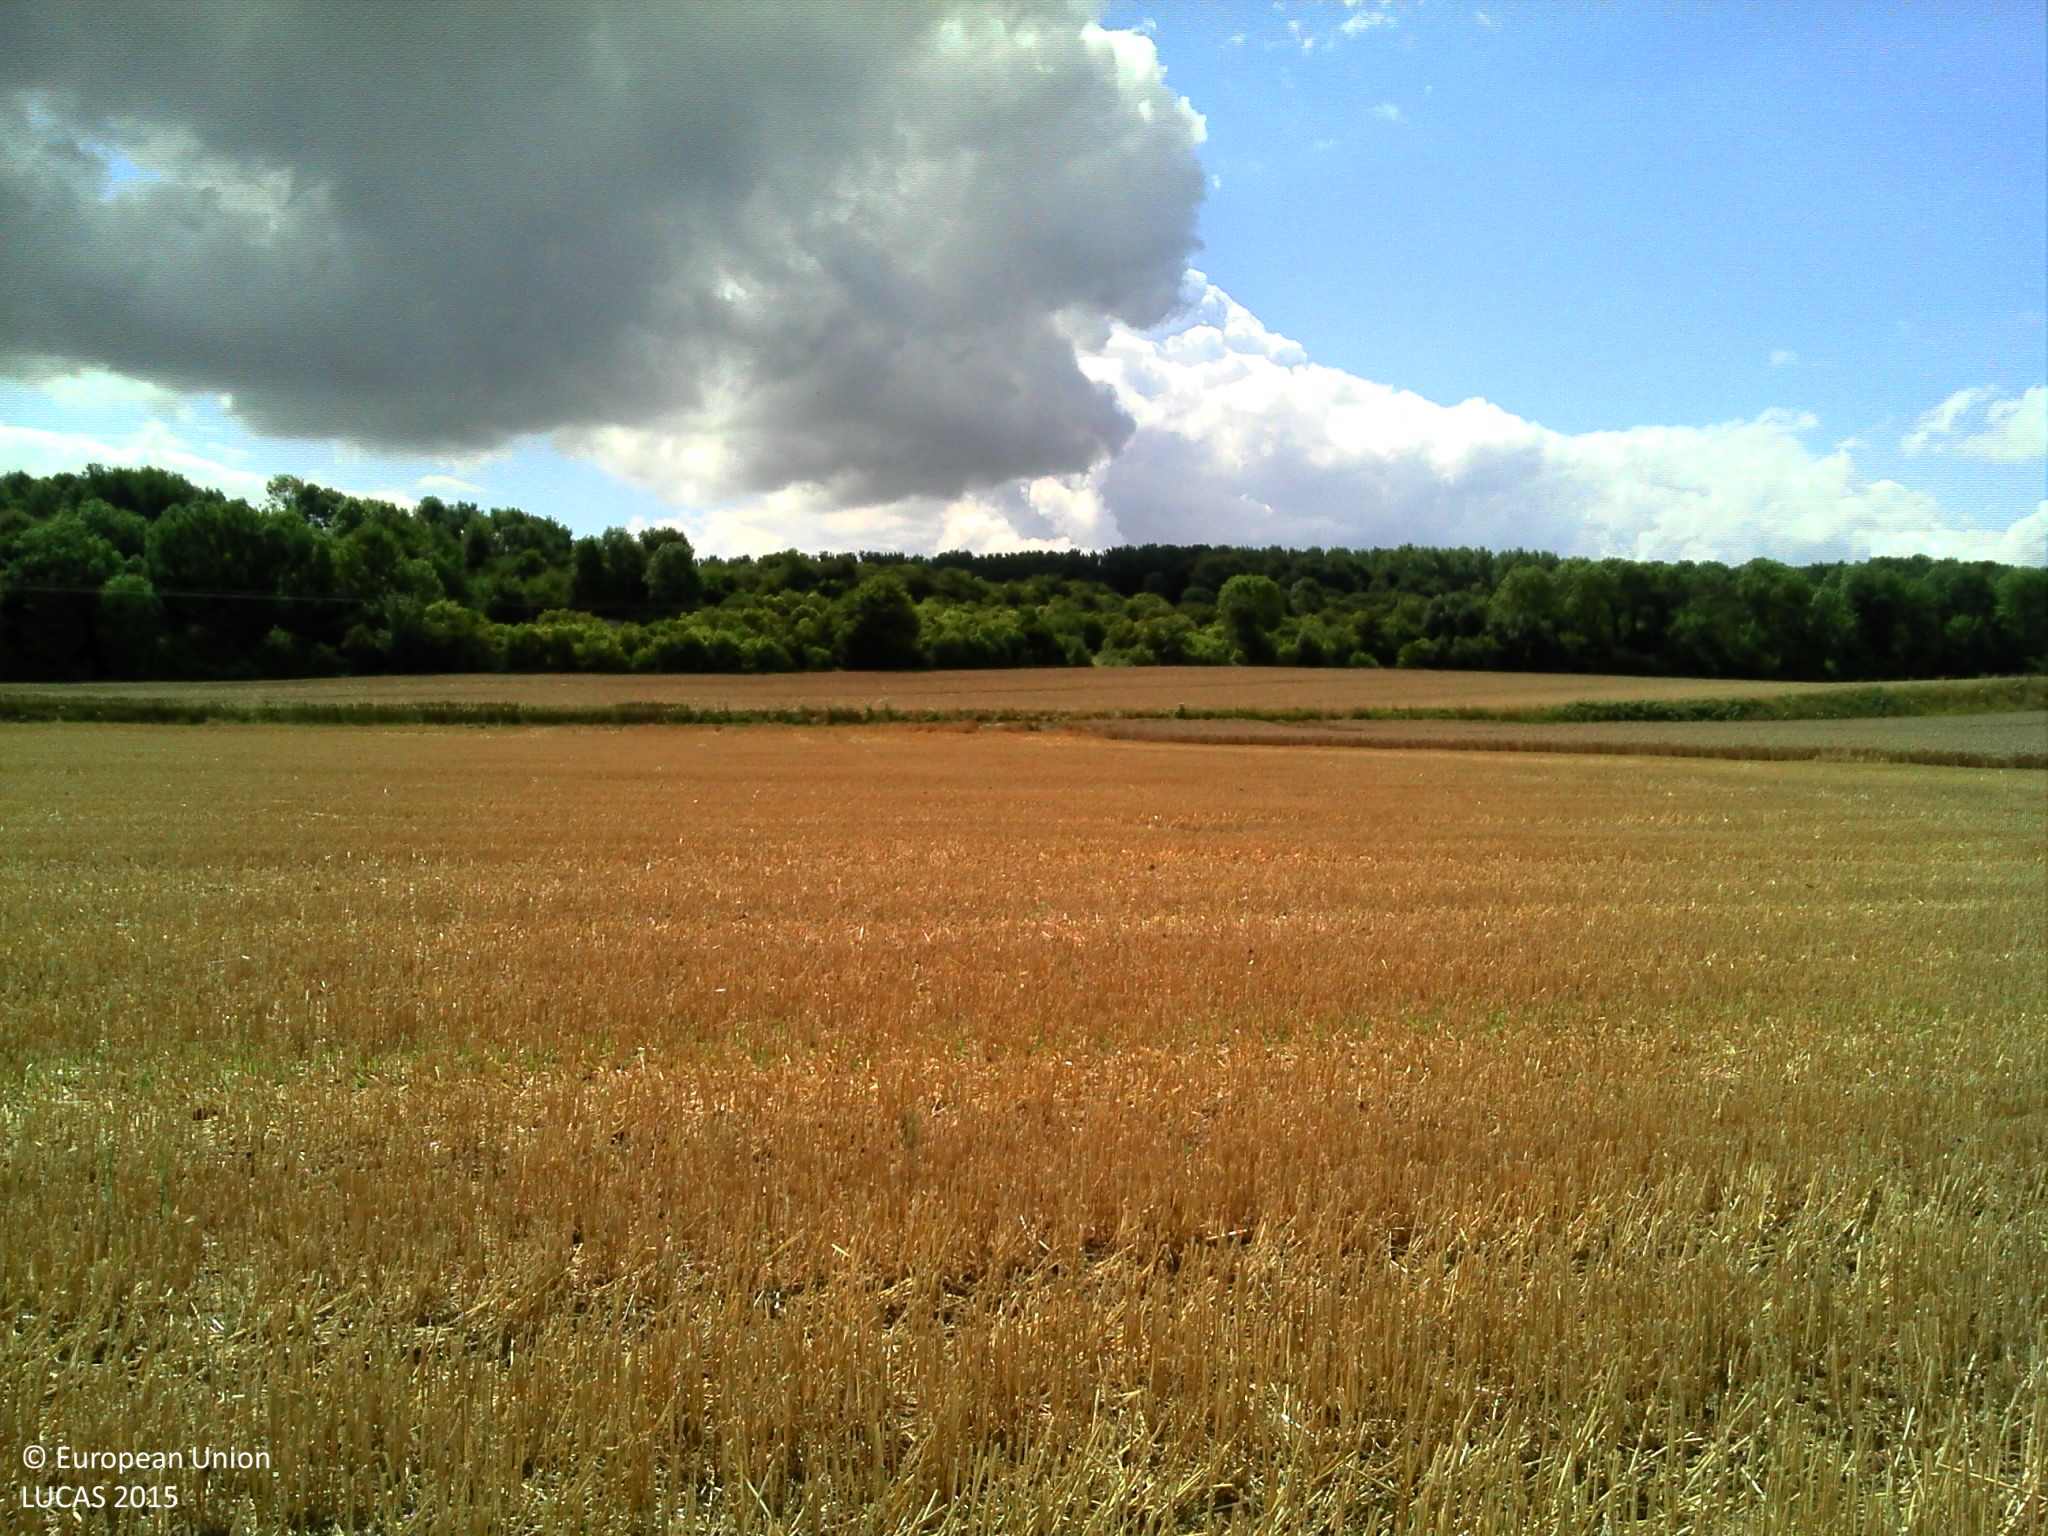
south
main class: Cropland
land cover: Barley
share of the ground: > 75 %
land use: Agriculture (excluding fallow land and kitchen gardens)
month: July
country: FR
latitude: 50.0126
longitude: 2.5500
